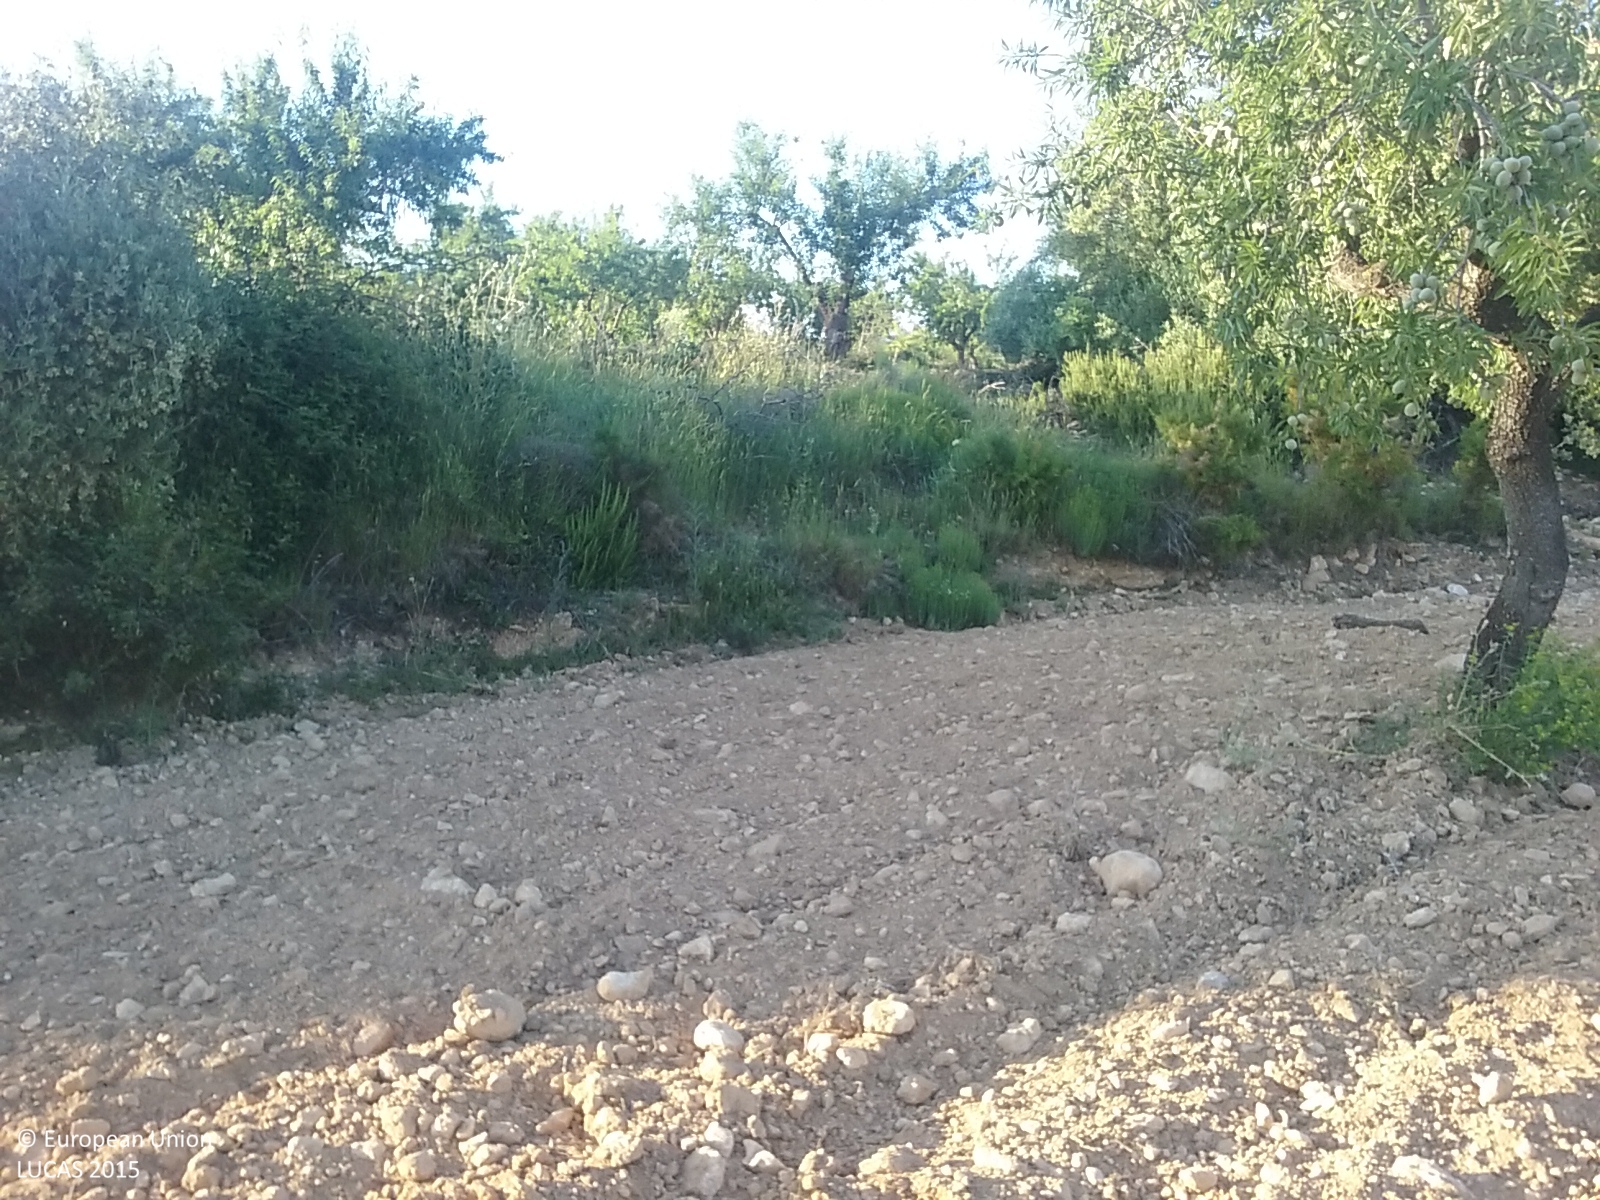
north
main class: Cropland
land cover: Nuts trees
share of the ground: 10 - 25 %
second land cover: Other bare soil
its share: > 75 %
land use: Agriculture (excluding fallow land and kitchen gardens)
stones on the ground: 10 - 25 %
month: May
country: ES
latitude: 40.2080
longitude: -0.0250
